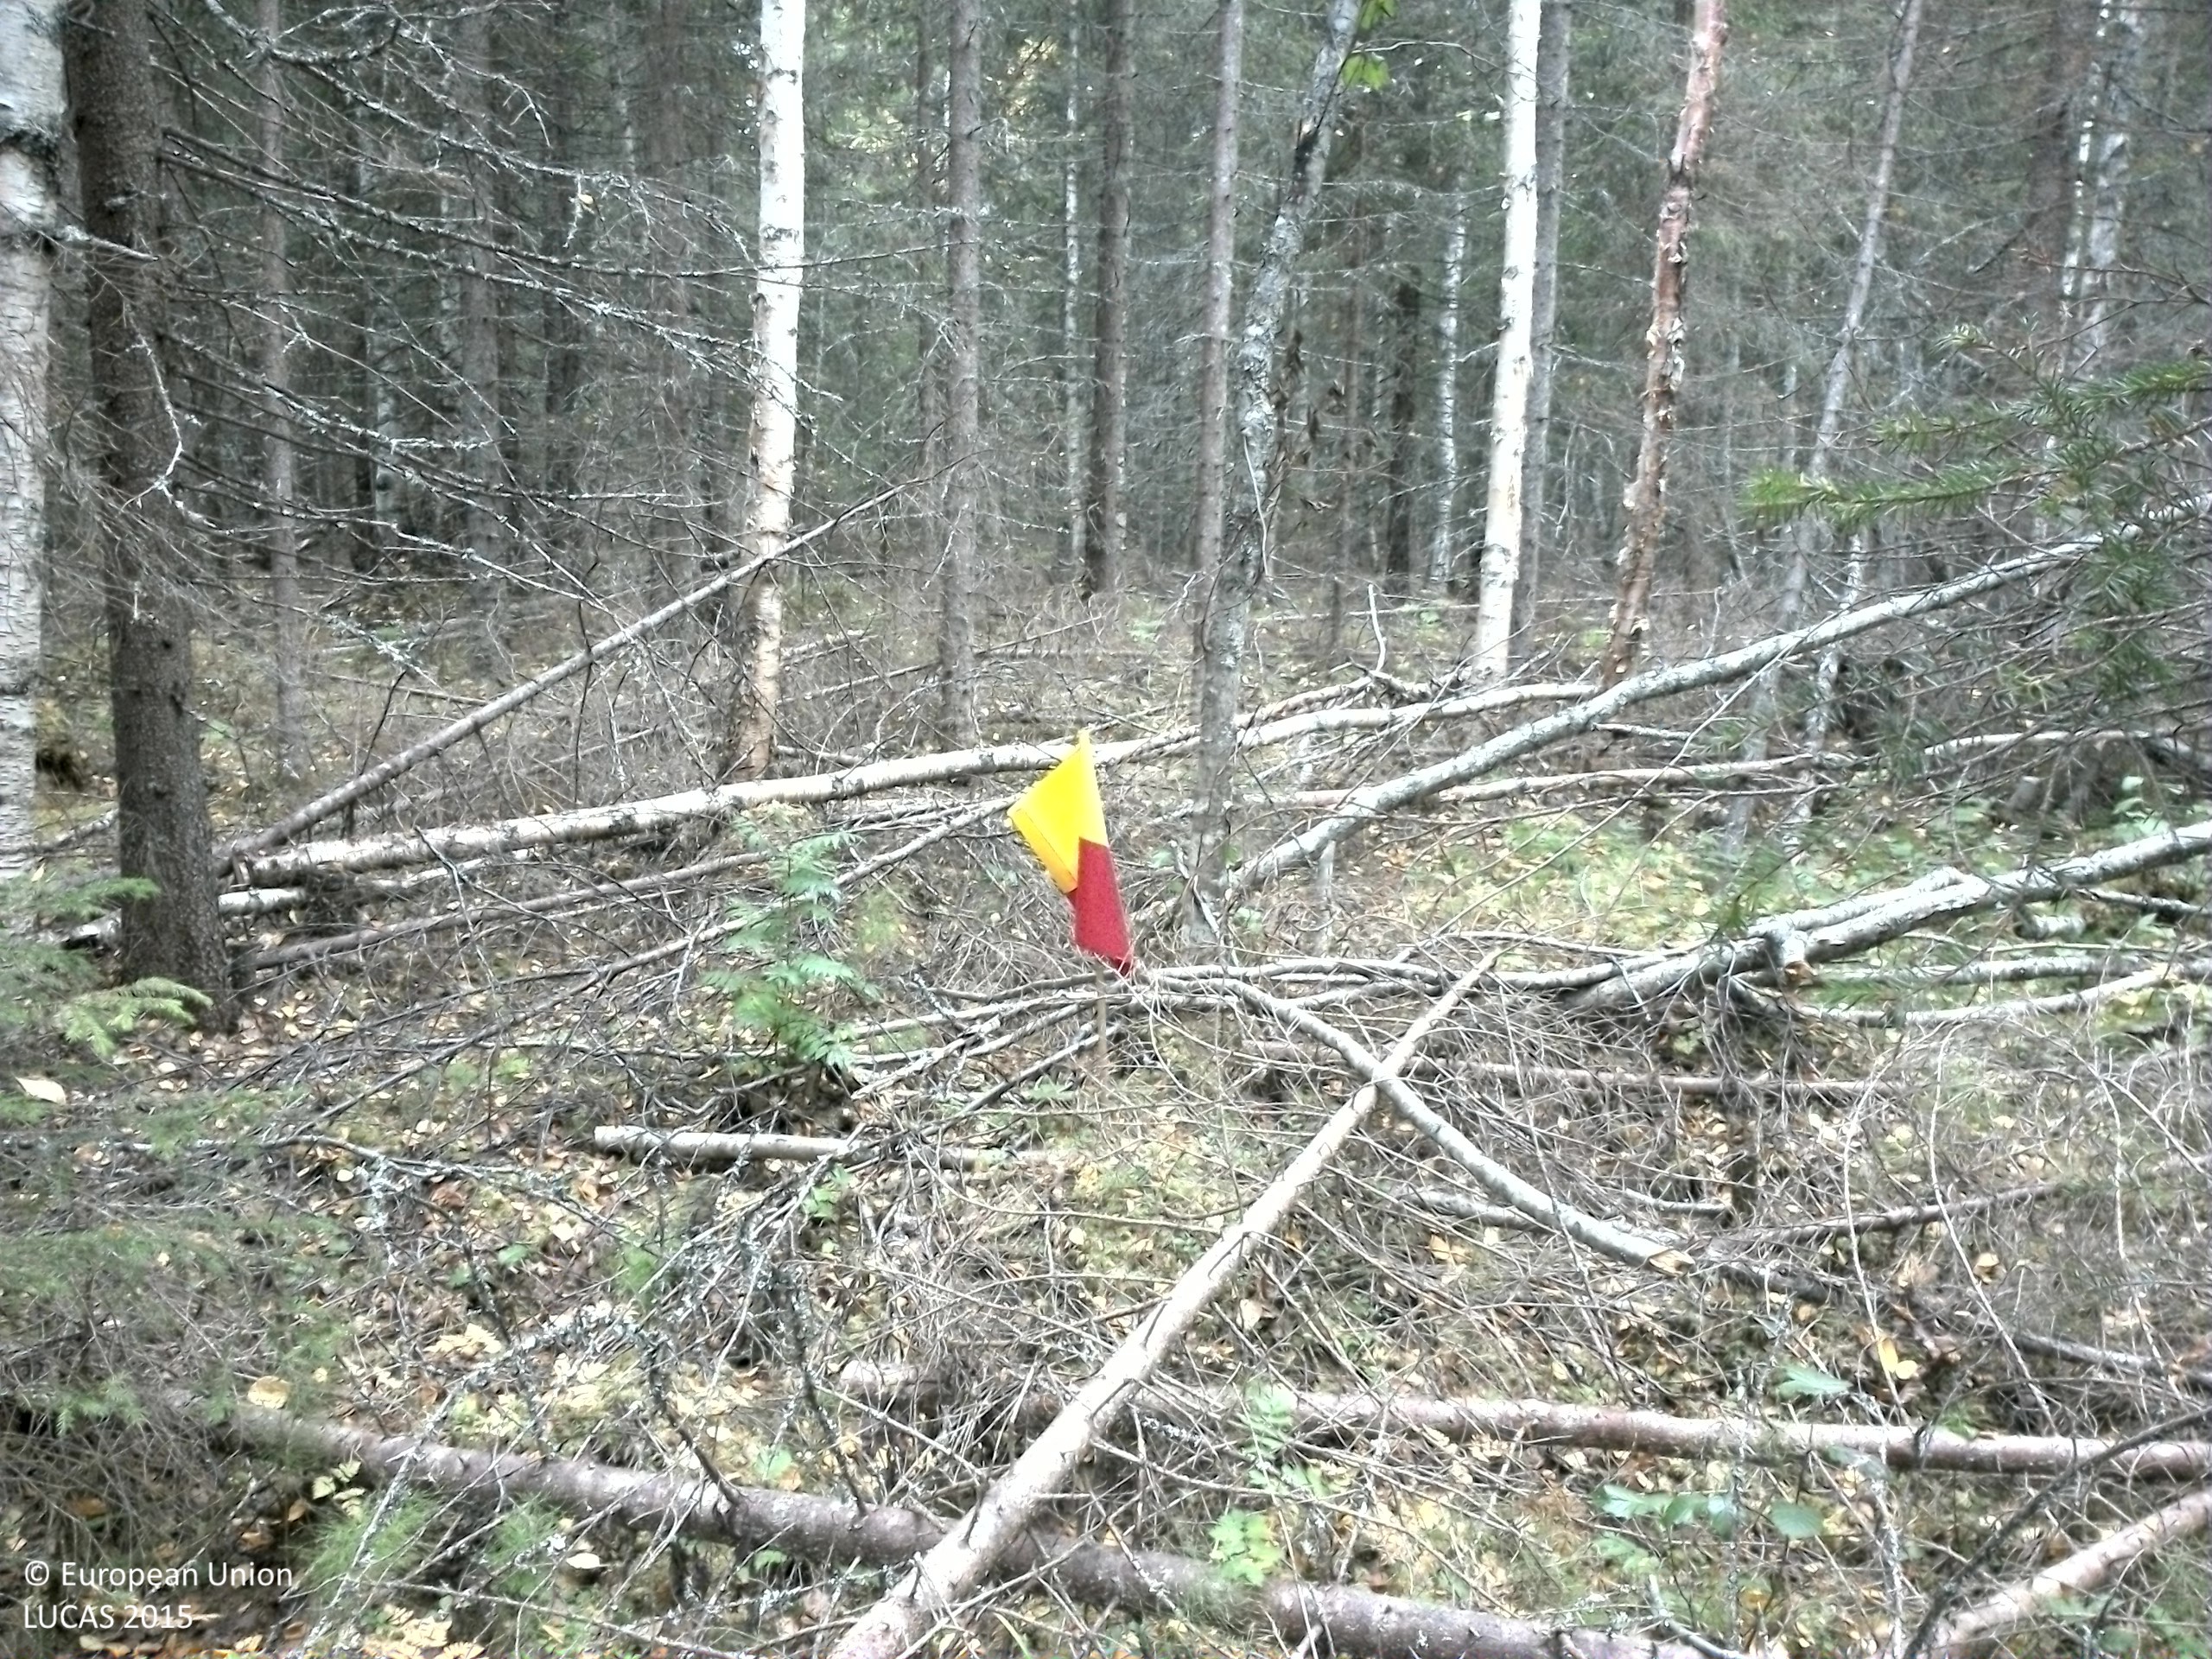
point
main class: Woodland
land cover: Spruce dominated mixed woodland
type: boreal forest
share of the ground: > 75 %
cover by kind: coniferous forest trees 55 %, broadleaved forest trees 20 %, lichens and mosses 10 %, unconsolidated bare surface 10 %, shrubs 5 %
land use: Forestry
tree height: > 5 m
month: September
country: SE
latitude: 63.6371
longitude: 15.8878
